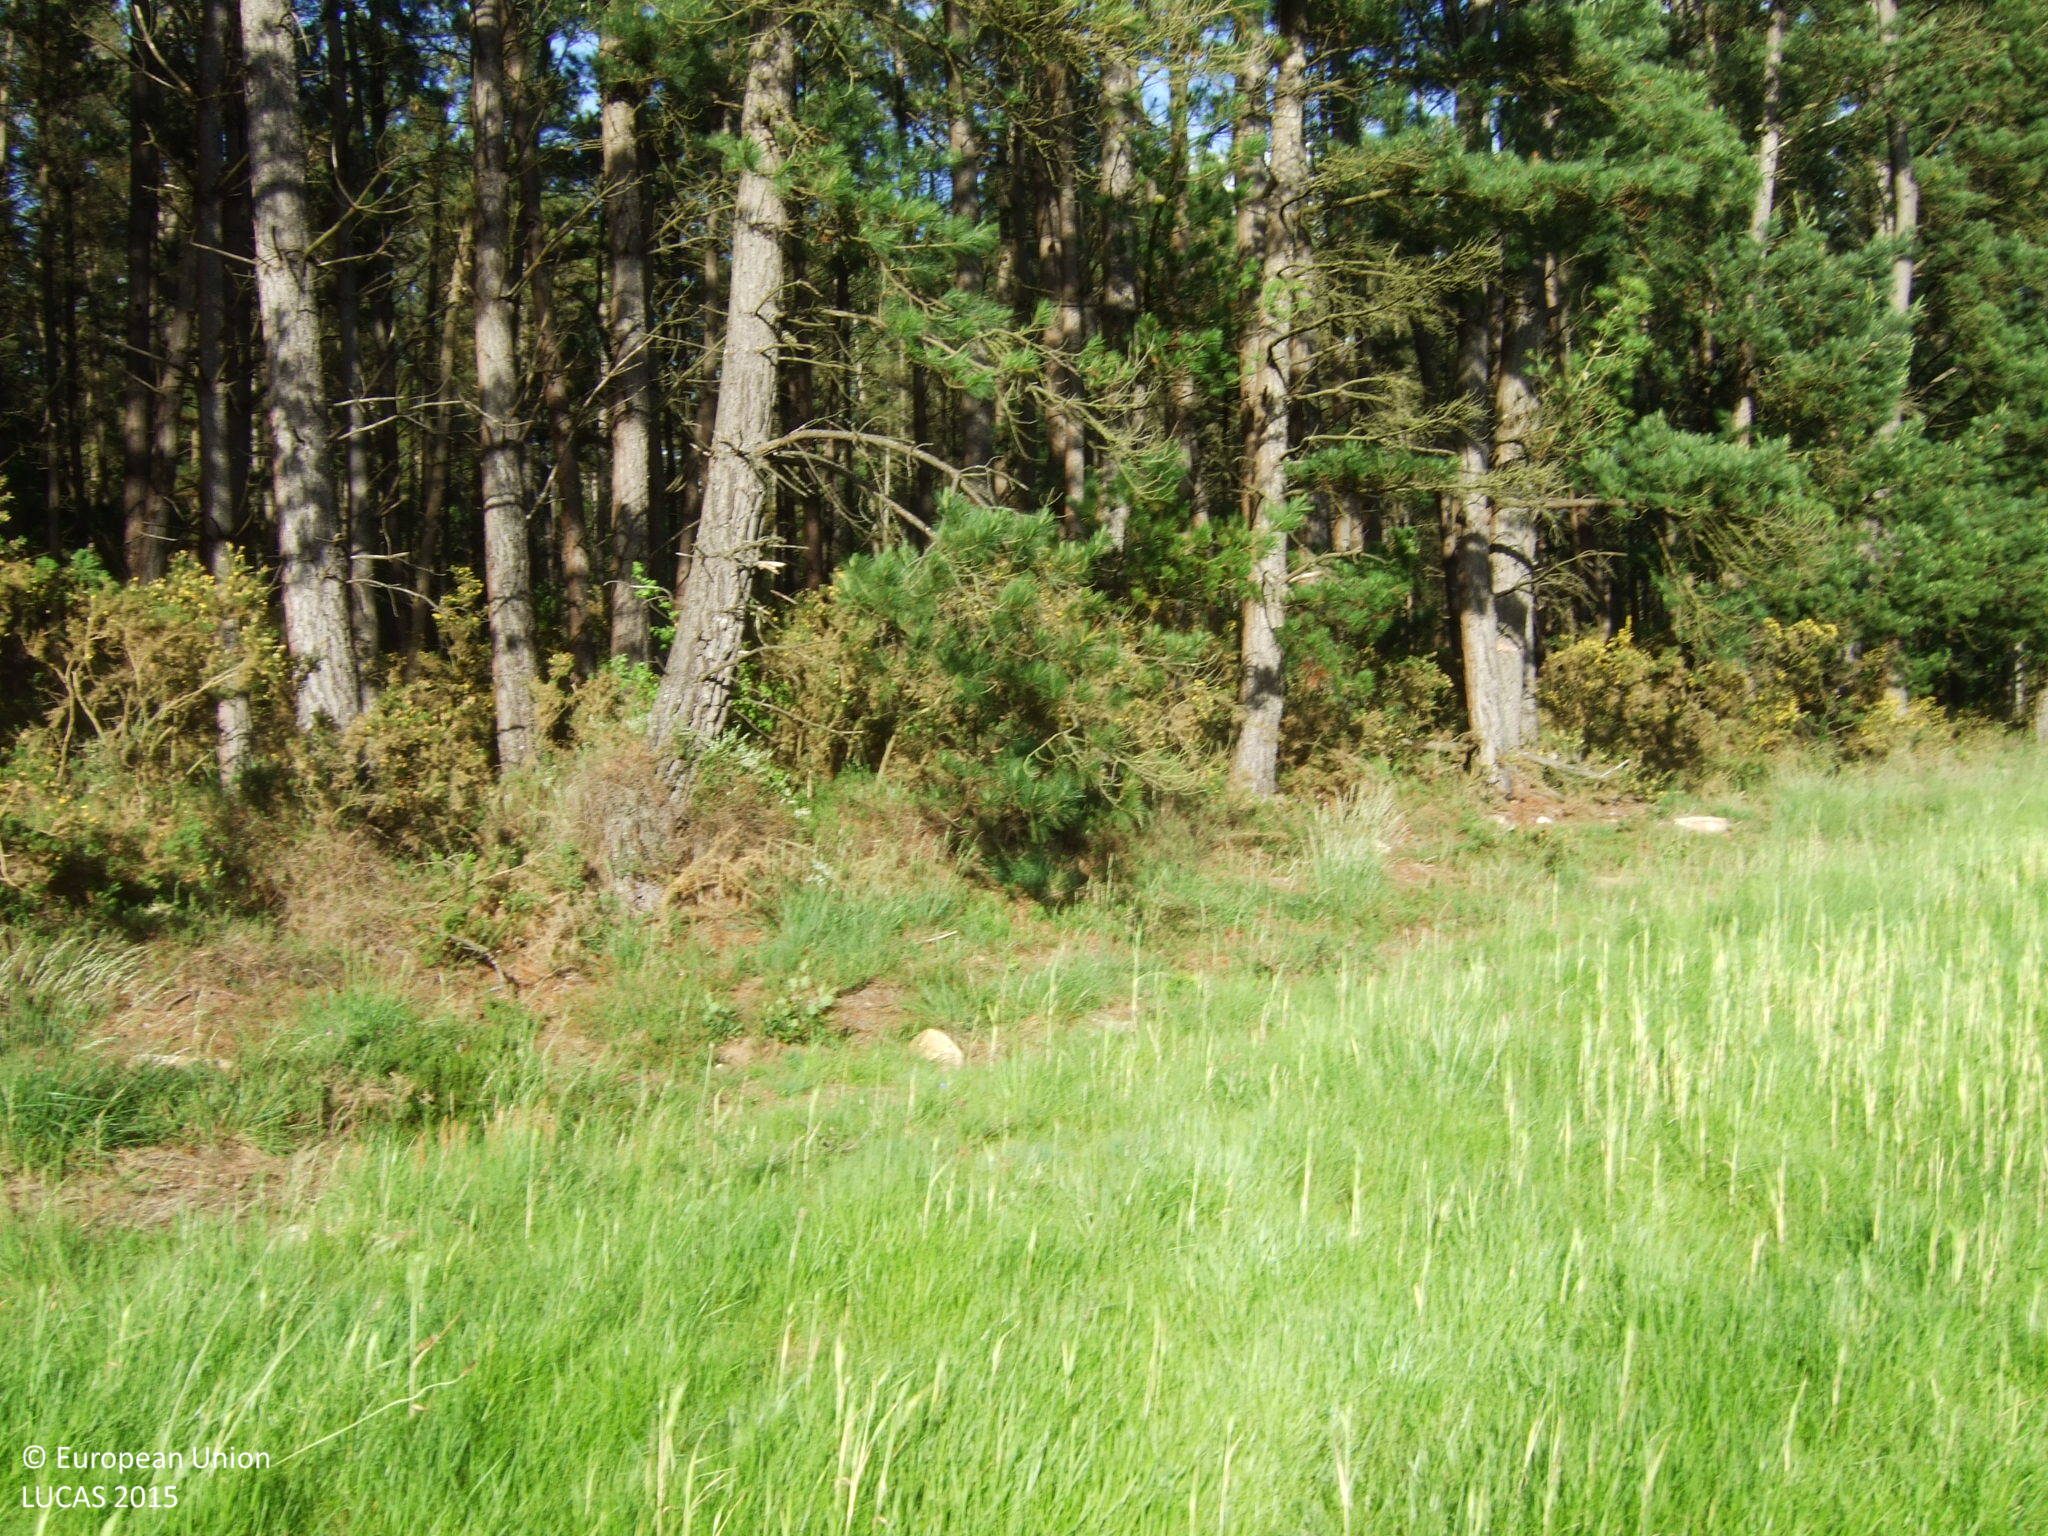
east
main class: Artificial land
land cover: Other artificial areas
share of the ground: < 10 %
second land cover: Grassland without tree/shrub cover
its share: > 75 %
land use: Electricity, gas and thermal power distribution
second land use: Agriculture (excluding fallow land and kitchen gardens)
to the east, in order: Artificial constructions in urban areas; Grassland without tree/shrub cover; Pine dominated coniferous woodland; Tracks; Pine dominated coniferous woodland
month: May
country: ES
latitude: 43.1523
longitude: -7.4519
